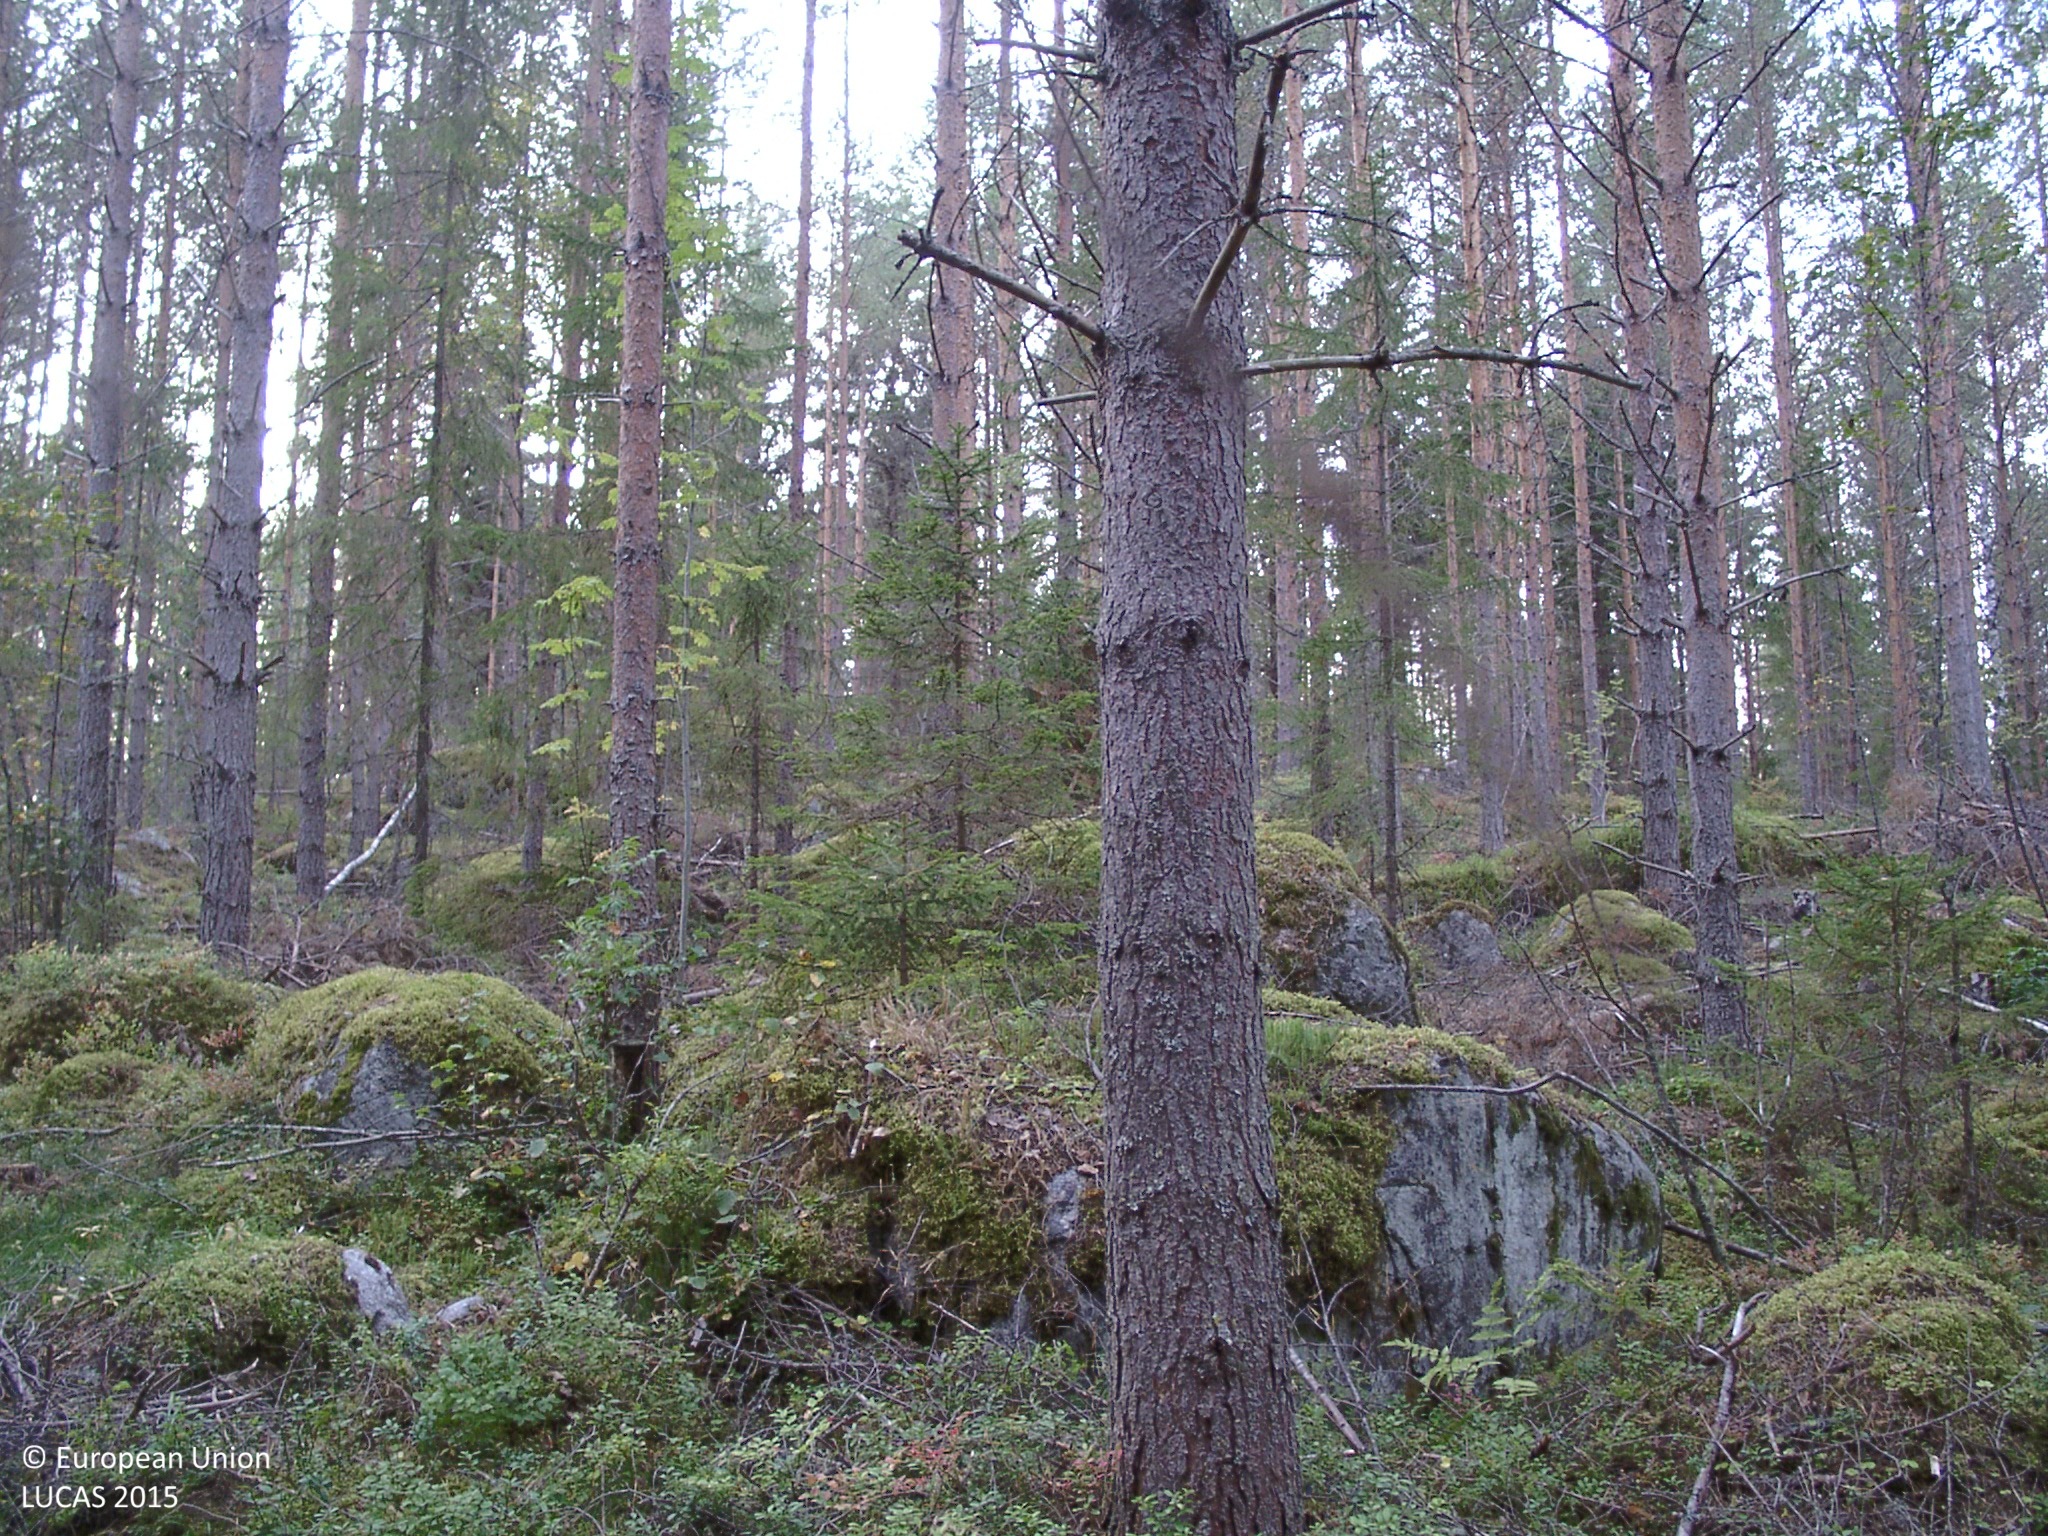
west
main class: Woodland
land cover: Spruce dominated coniferous woodland
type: boreal forest
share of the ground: > 75 %
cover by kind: coniferous forest trees 75 %, unconsolidated bare surface 15 %, lichens and mosses 10 %
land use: Forestry
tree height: > 5 m
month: September
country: FI
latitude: 62.5566
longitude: 25.6949
